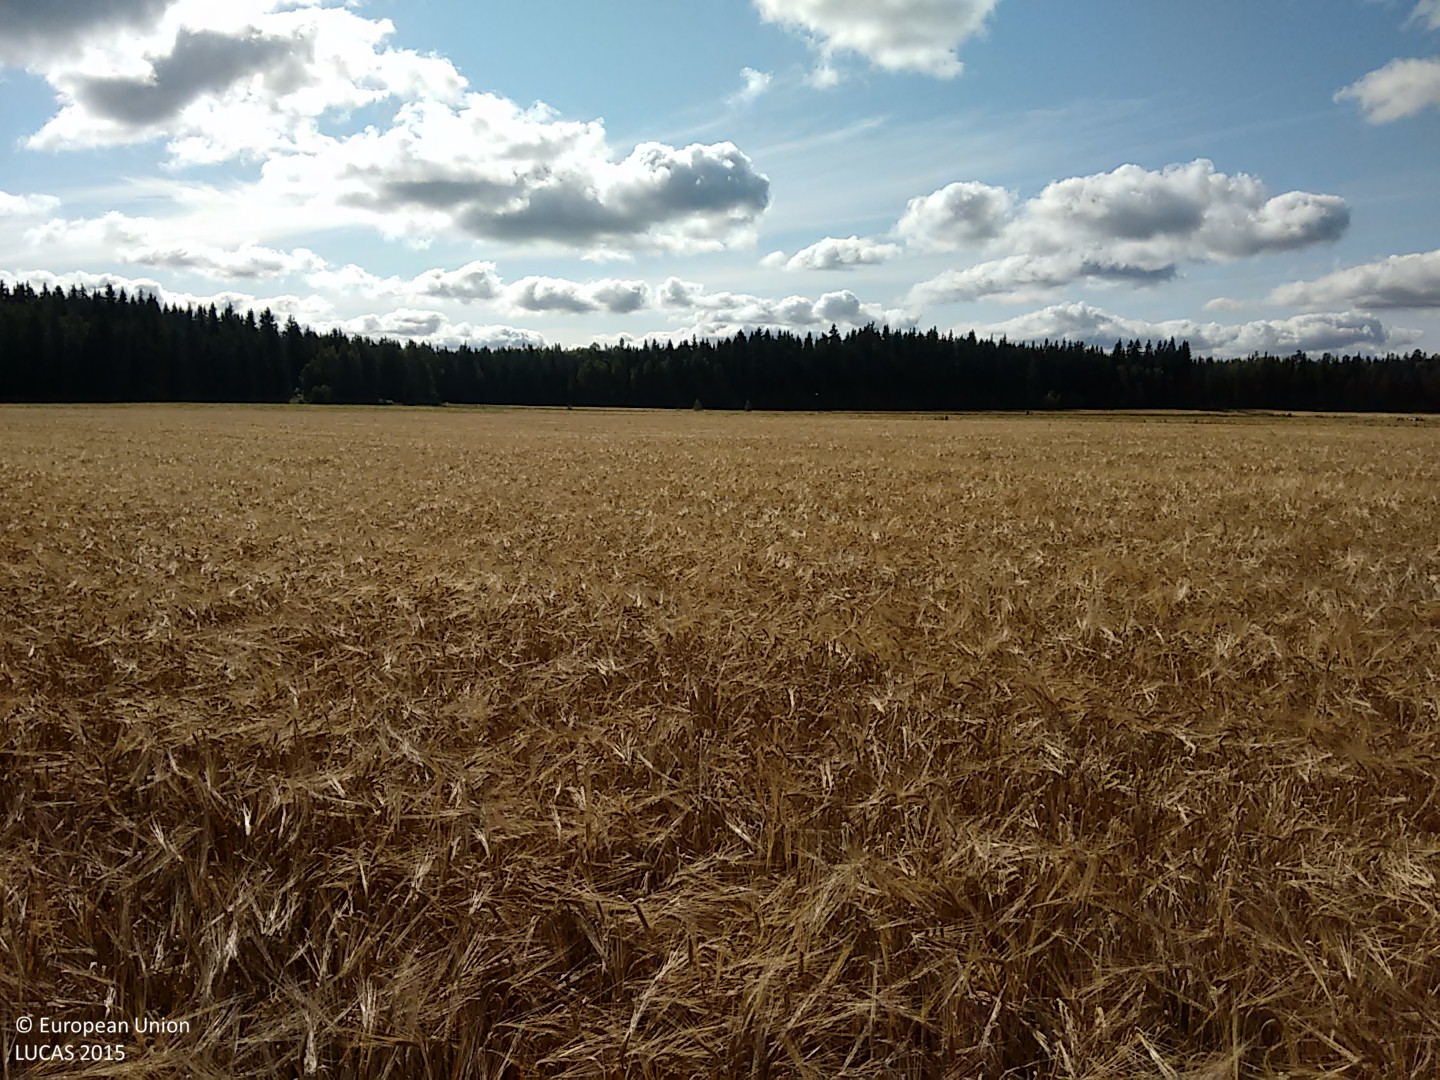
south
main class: Cropland
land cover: Barley
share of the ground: > 75 %
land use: Agriculture (excluding fallow land and kitchen gardens)
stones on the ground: < 10 %
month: September
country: FI
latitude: 60.8697
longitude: 21.7887
